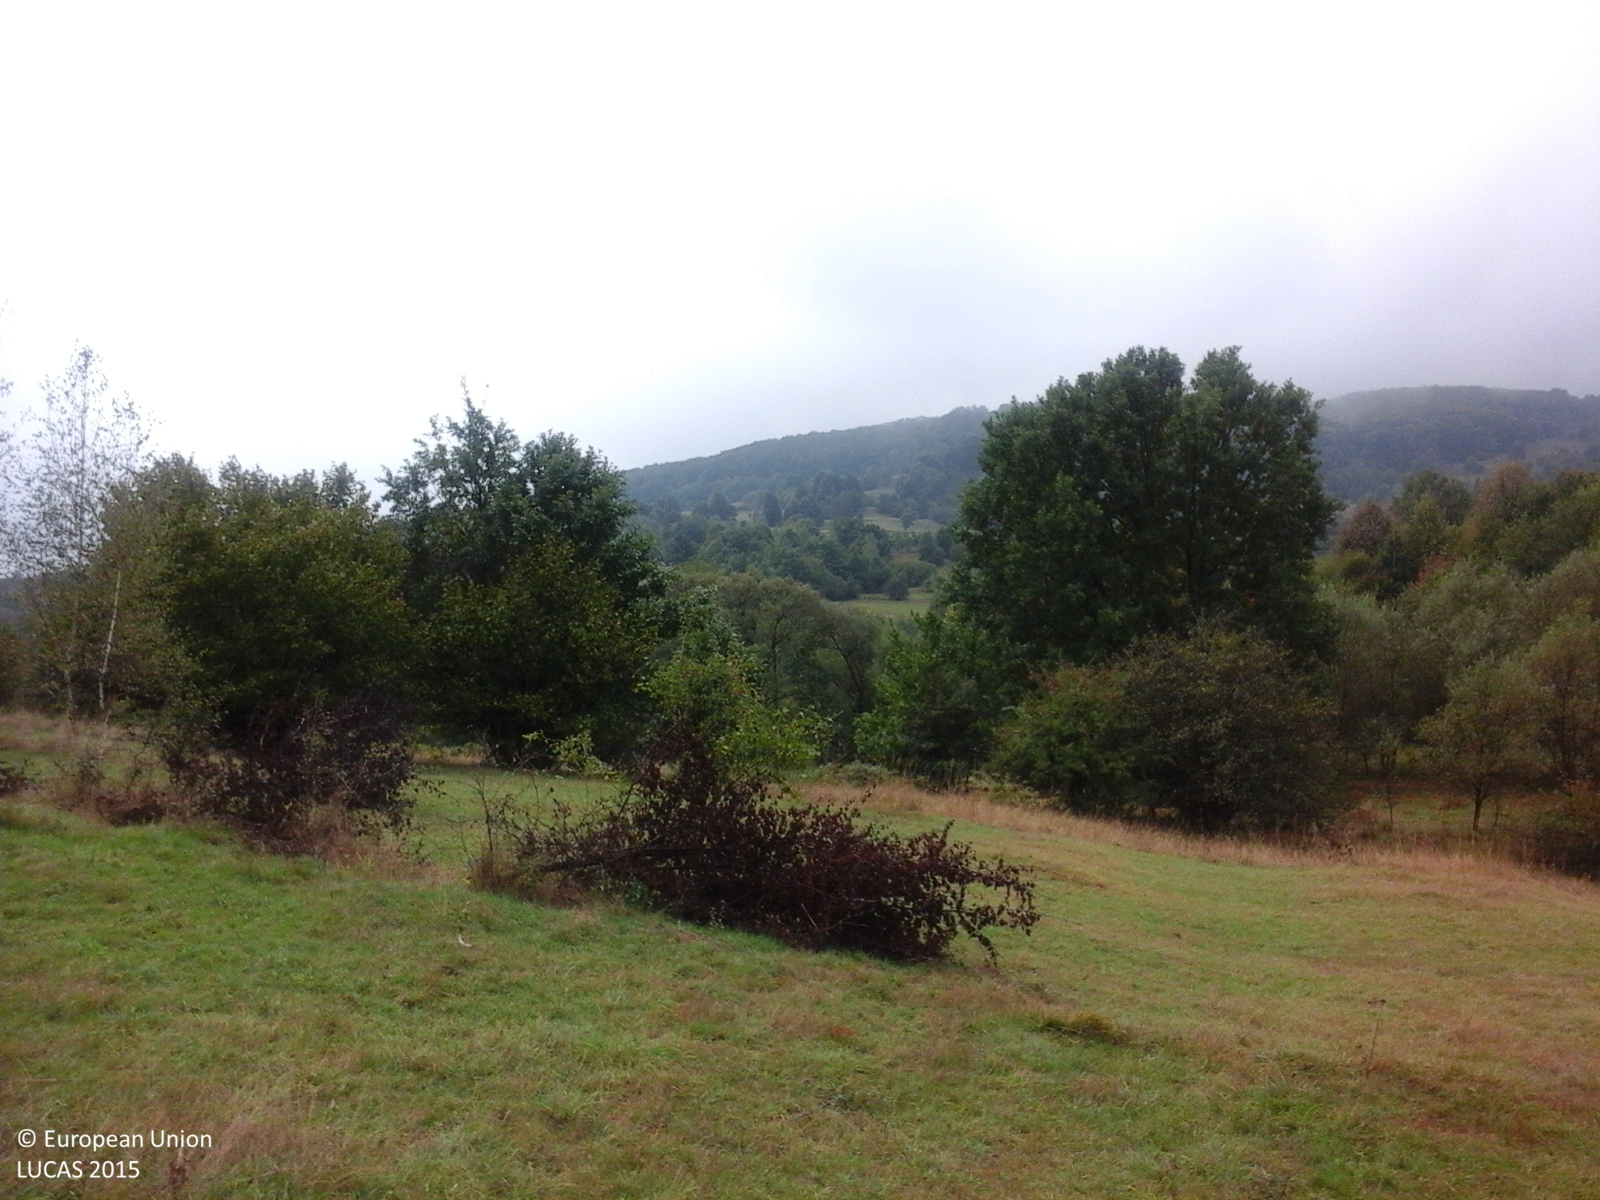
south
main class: Grassland
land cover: Grassland without tree/shrub cover
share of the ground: > 75 %
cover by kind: herbaceous plants 100 %
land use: Agriculture (excluding fallow land and kitchen gardens)
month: September
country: RO
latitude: 45.1516
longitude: 23.5806
